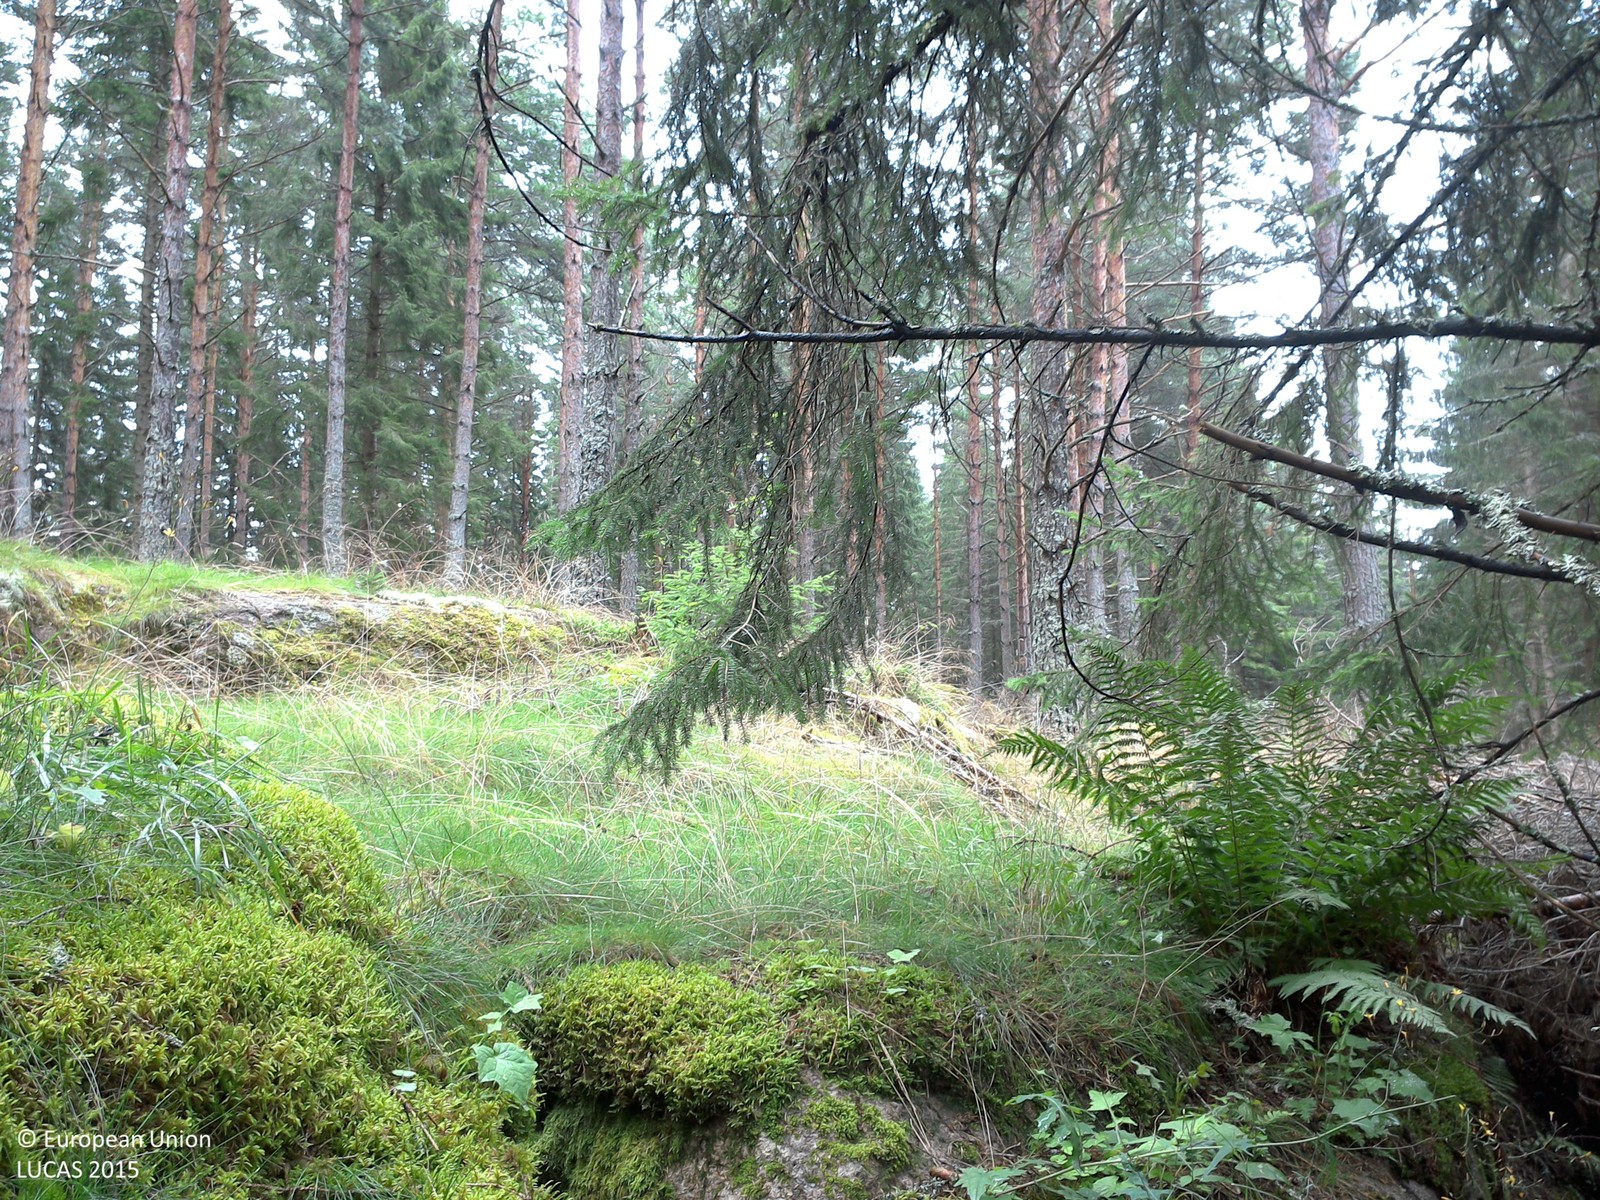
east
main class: Woodland
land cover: Spruce dominated coniferous woodland
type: boreal forest
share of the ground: 50 - 75 %
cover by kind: coniferous forest trees 60 %, herbaceous plants 25 %, lichens and mosses 10 %, broadleaved forest trees 5 %
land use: Forestry
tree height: > 5 m
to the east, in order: Spruce dominated coniferous woodland; Pine dominated coniferous woodland; Spruce dominated coniferous woodland; Tracks; Spruce dominated coniferous woodland; Spruce dominated mixed woodland
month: August
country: SE
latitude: 58.2375
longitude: 15.3940
